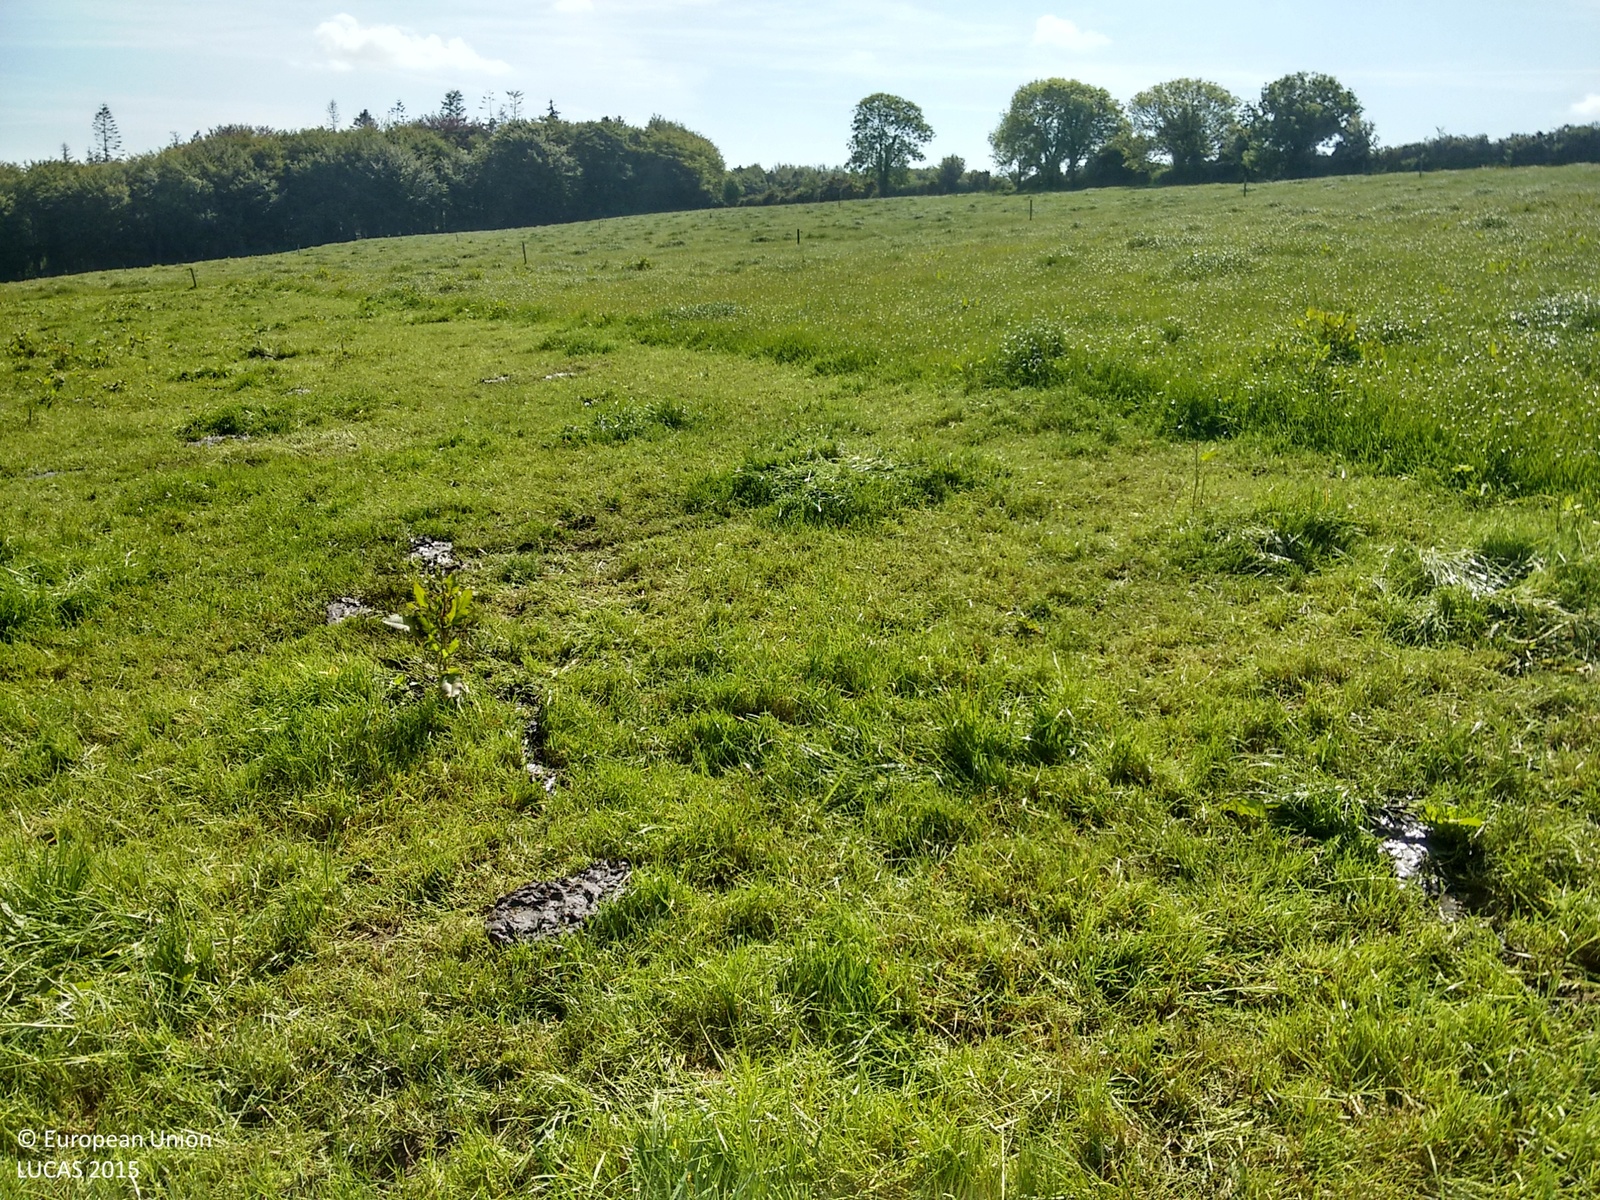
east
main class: Grassland
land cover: Grassland without tree/shrub cover
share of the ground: > 75 %
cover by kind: herbaceous plants 100 %
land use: Agriculture (excluding fallow land and kitchen gardens)
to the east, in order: Grassland without tree/shrub cover; Fences; Grassland without tree/shrub cover; Fences; Grassland without tree/shrub cover; Fences; Grassland without tree/shrub cover; Fences; Artificial constructions; Broadleaved woodland
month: June
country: IE
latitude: 51.7837
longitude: -8.7735
